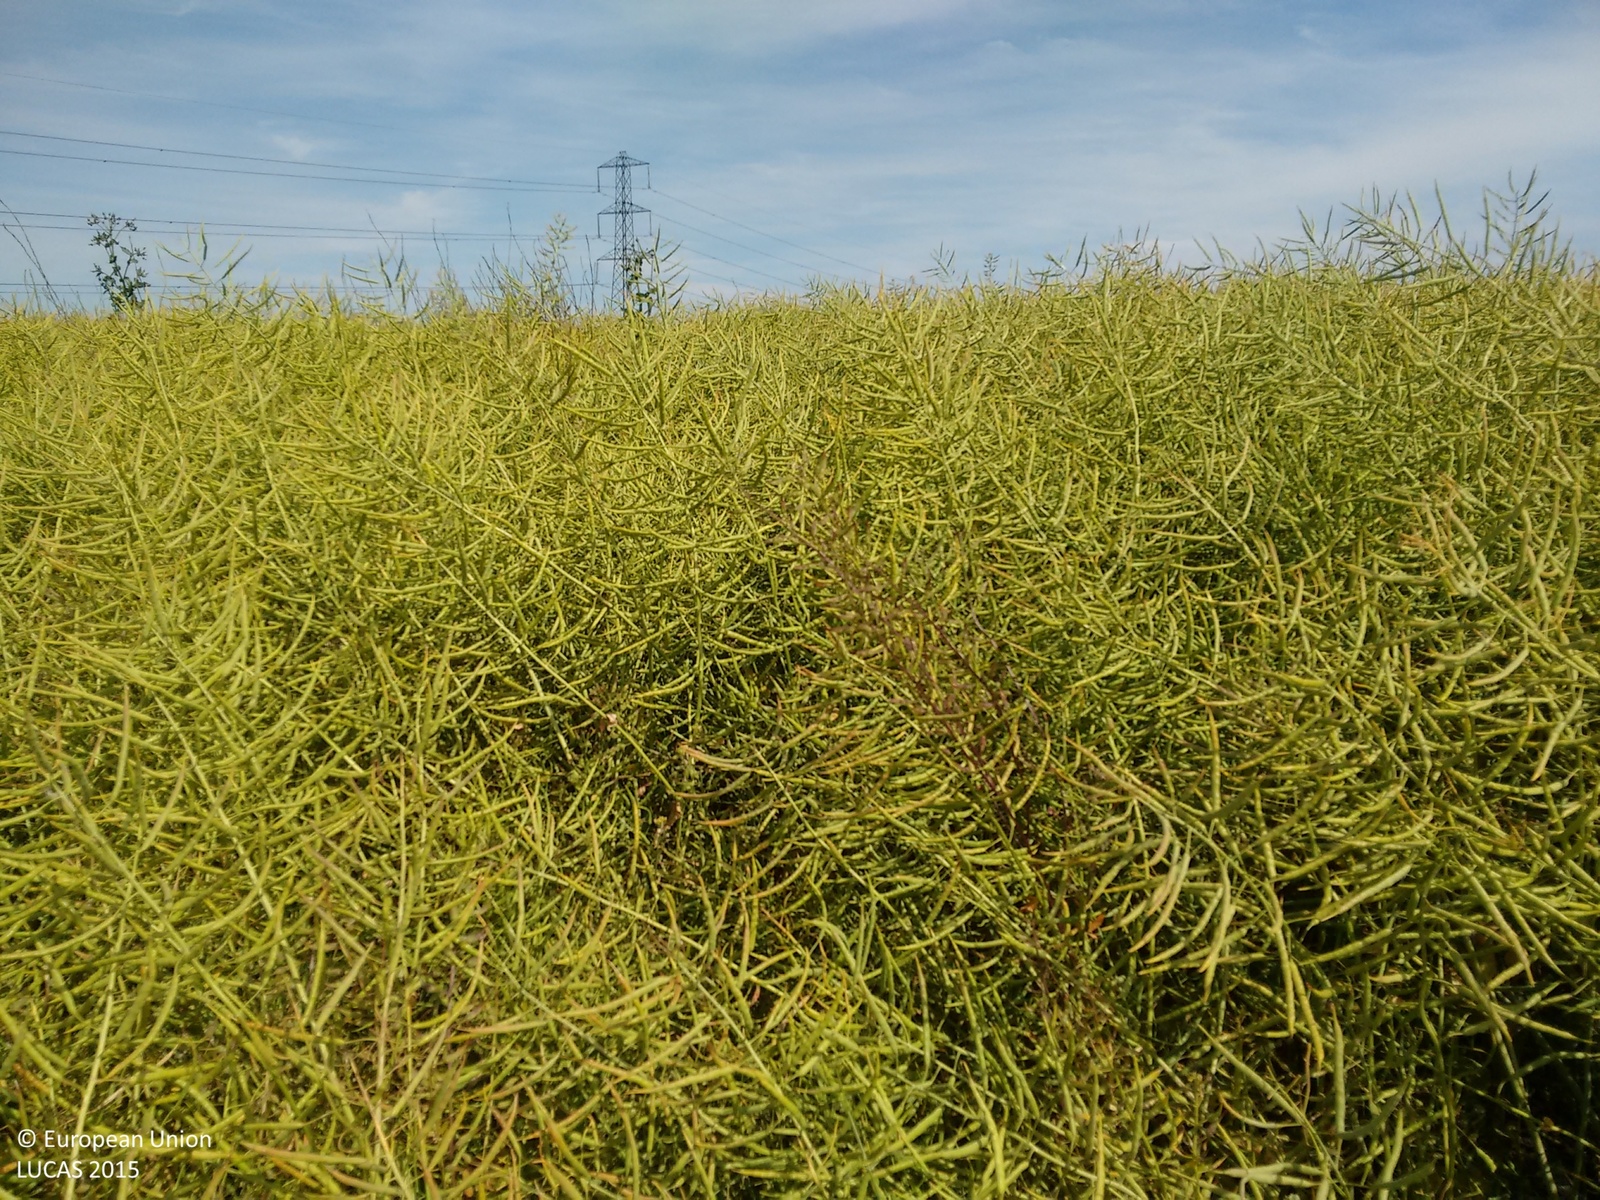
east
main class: Cropland
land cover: Rape and turnip rape
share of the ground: > 75 %
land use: Agriculture (excluding fallow land and kitchen gardens)
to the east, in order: Rape and turnip rape; Electric lines; Rape and turnip rape
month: July
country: GB
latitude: 52.9319
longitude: -1.0386
